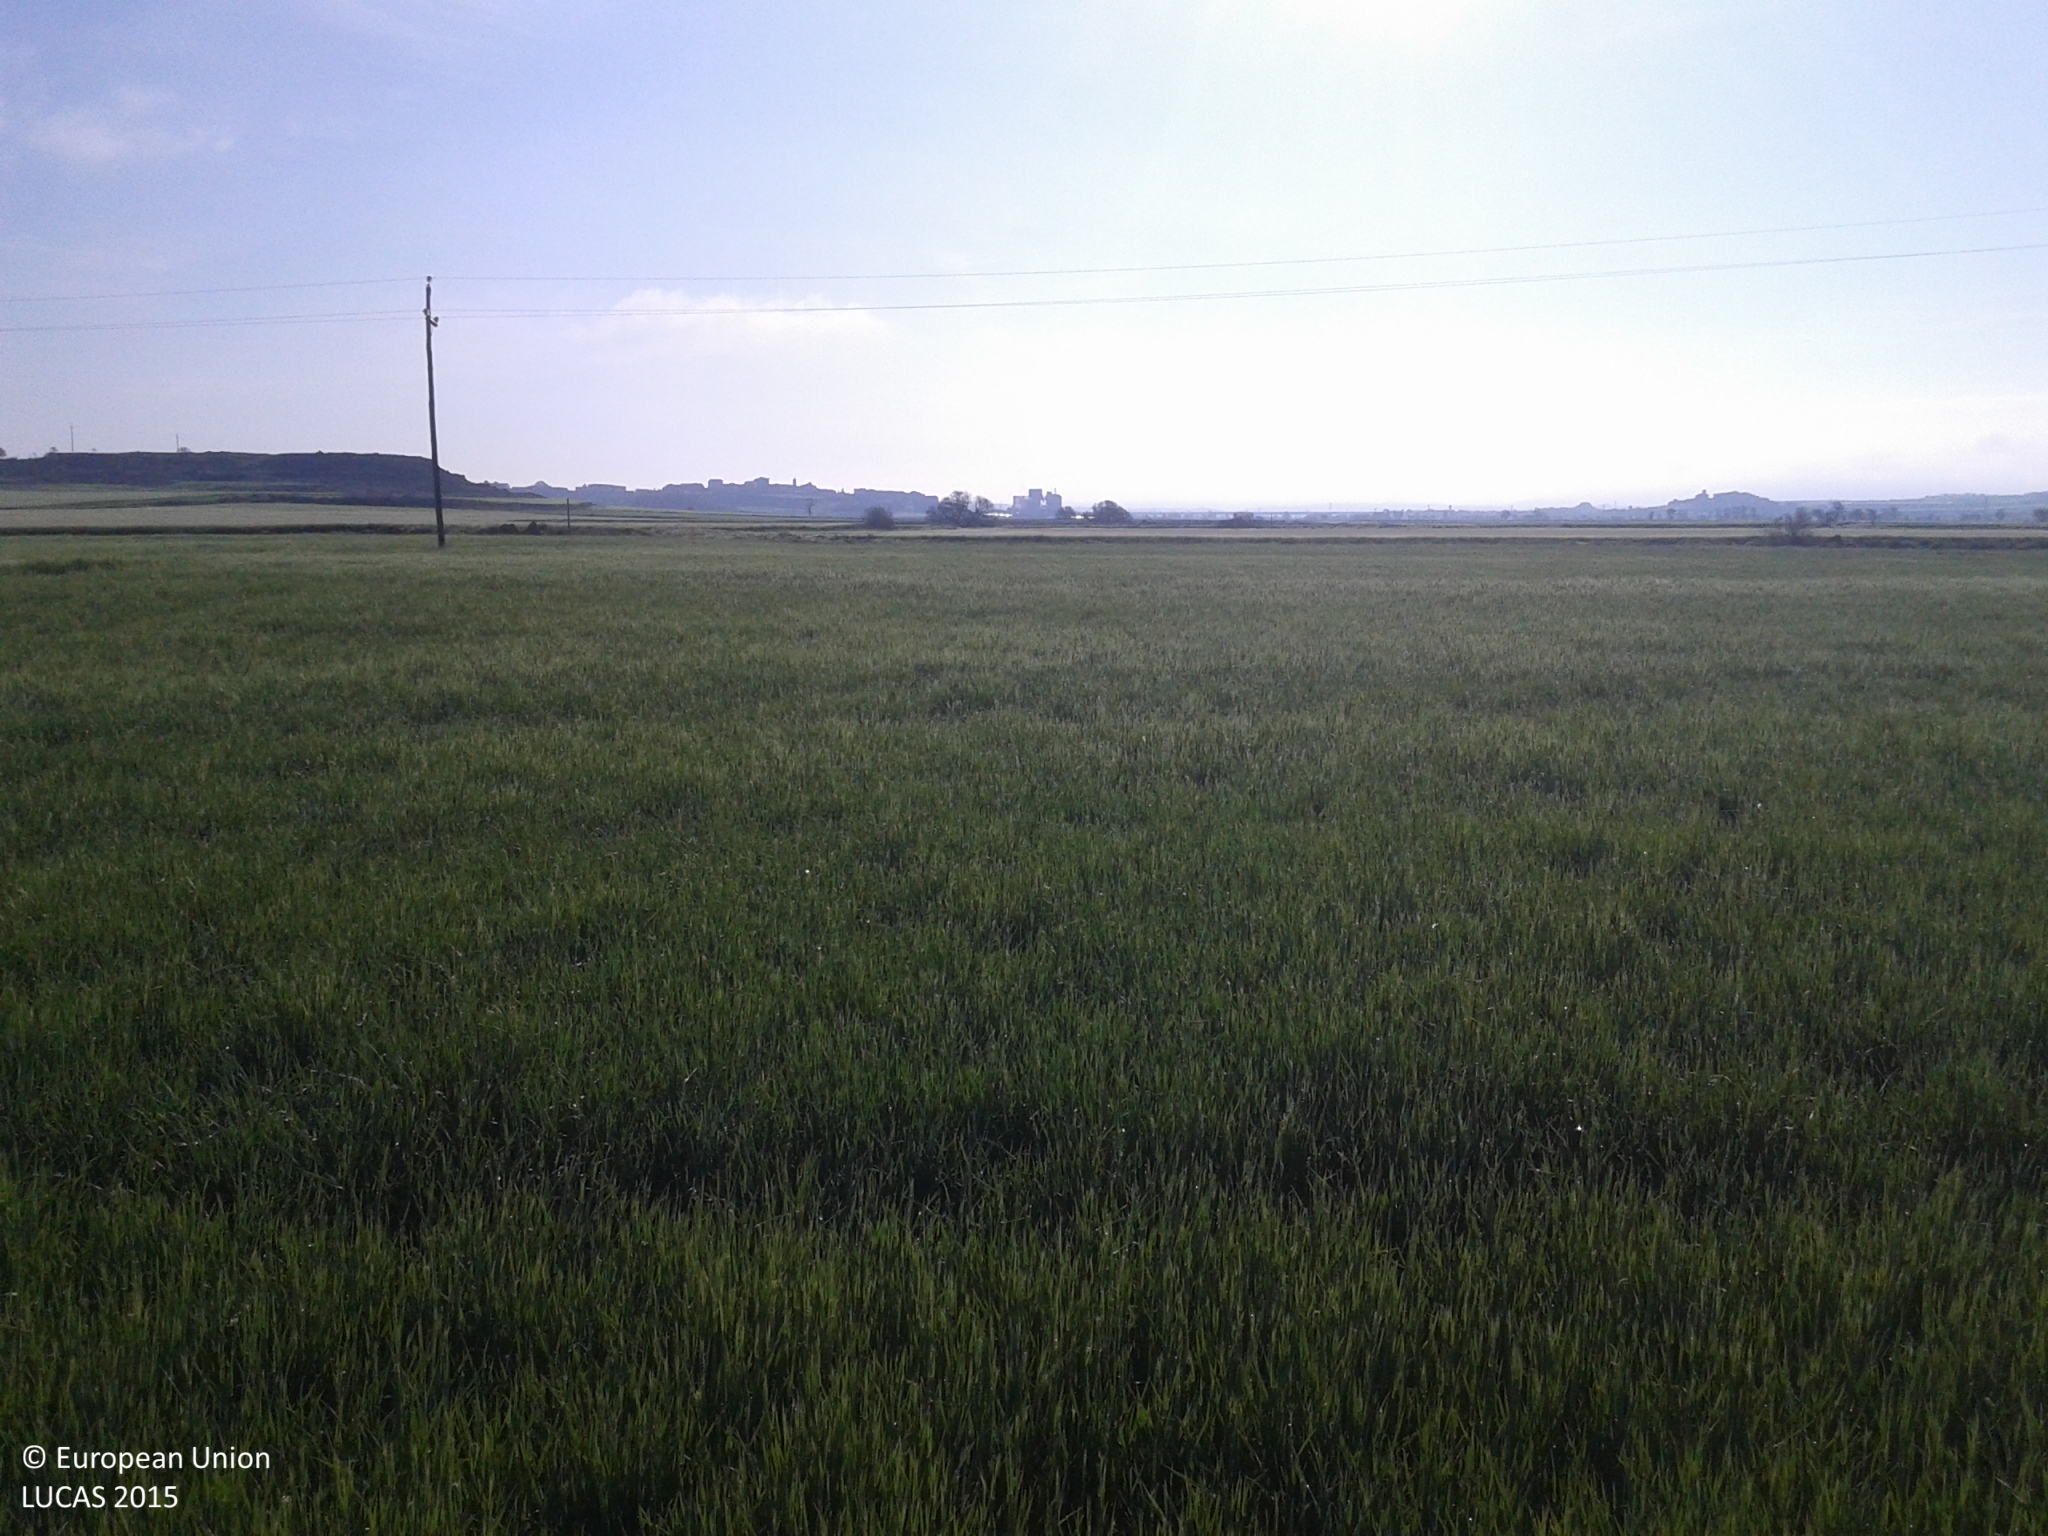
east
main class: Cropland
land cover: Barley
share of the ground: > 75 %
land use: Agriculture (excluding fallow land and kitchen gardens)
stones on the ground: 10 - 25 %
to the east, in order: Barley; Grass margins; Barley; Electric lines; Barley; Grass margins; Tracks; Grass margins; Barley; Grass margins; Tracks; Grass margins; Barley
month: April
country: ES
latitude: 41.7595
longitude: 1.1726
